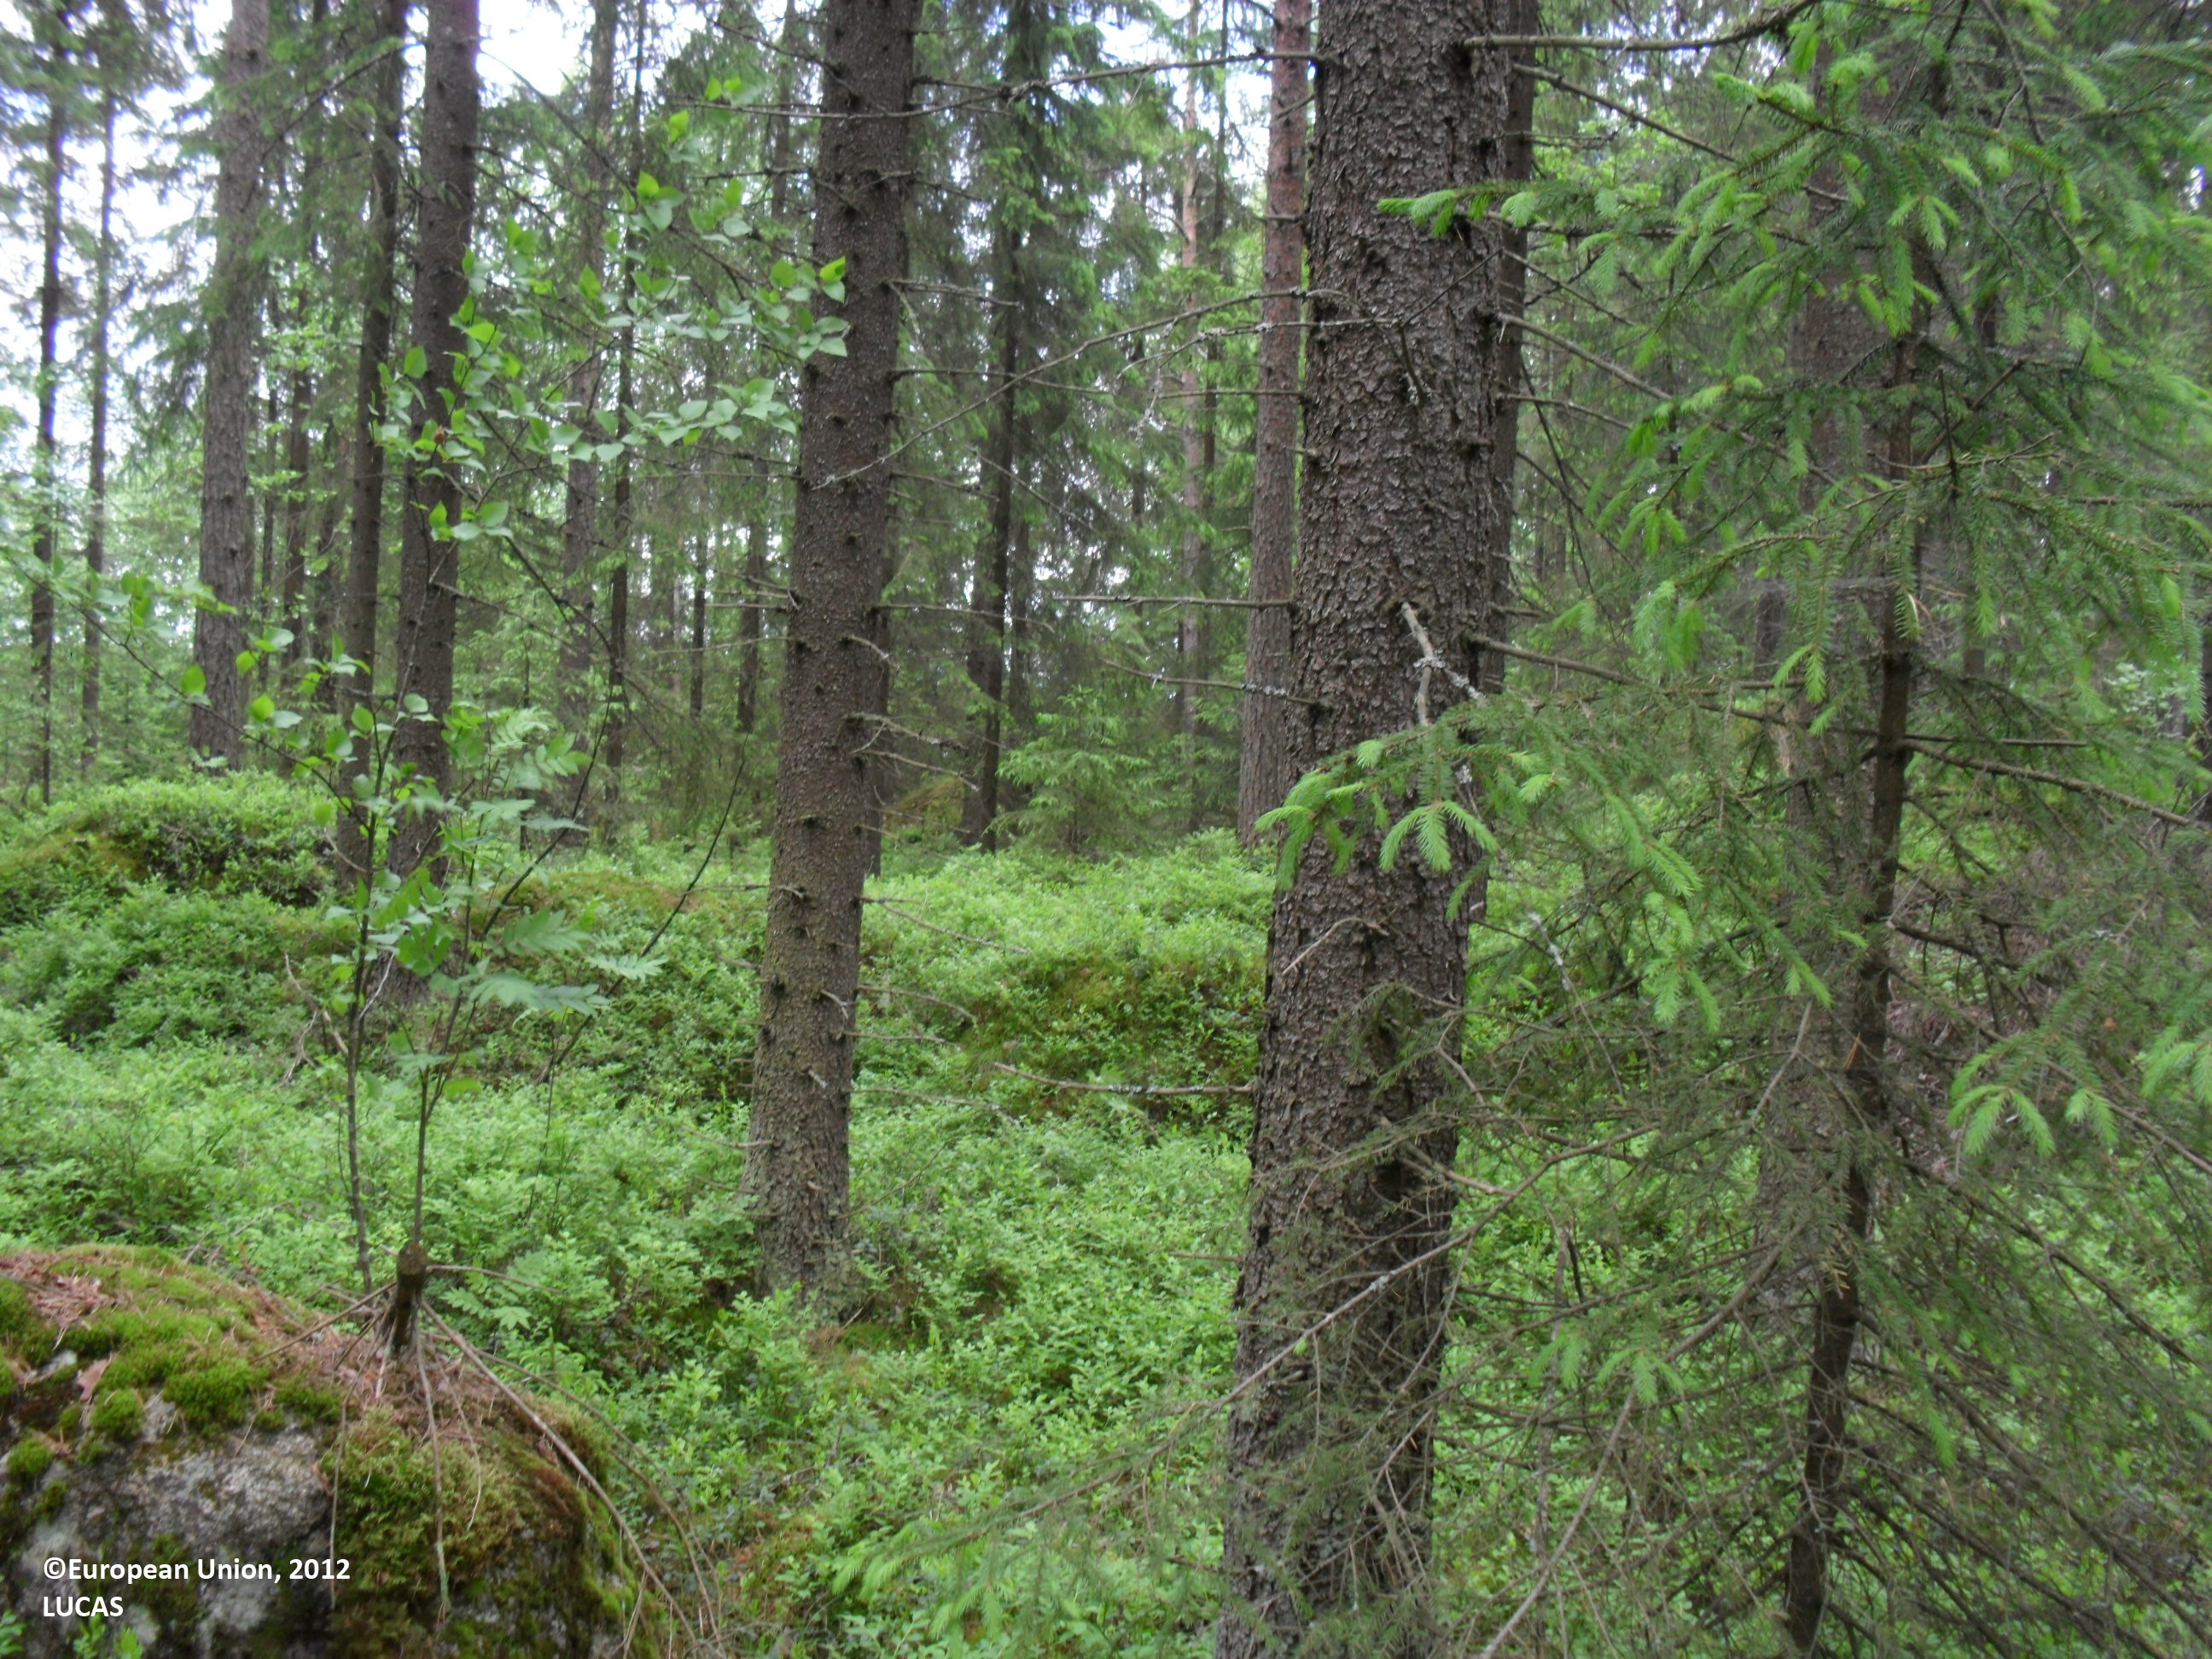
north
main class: Woodland
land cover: Spruce dominated coniferous woodland
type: boreal forest
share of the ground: 50 - 75 %
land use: Forestry
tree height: > 5 m
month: June
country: FI
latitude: 63.2292
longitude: 23.0924
